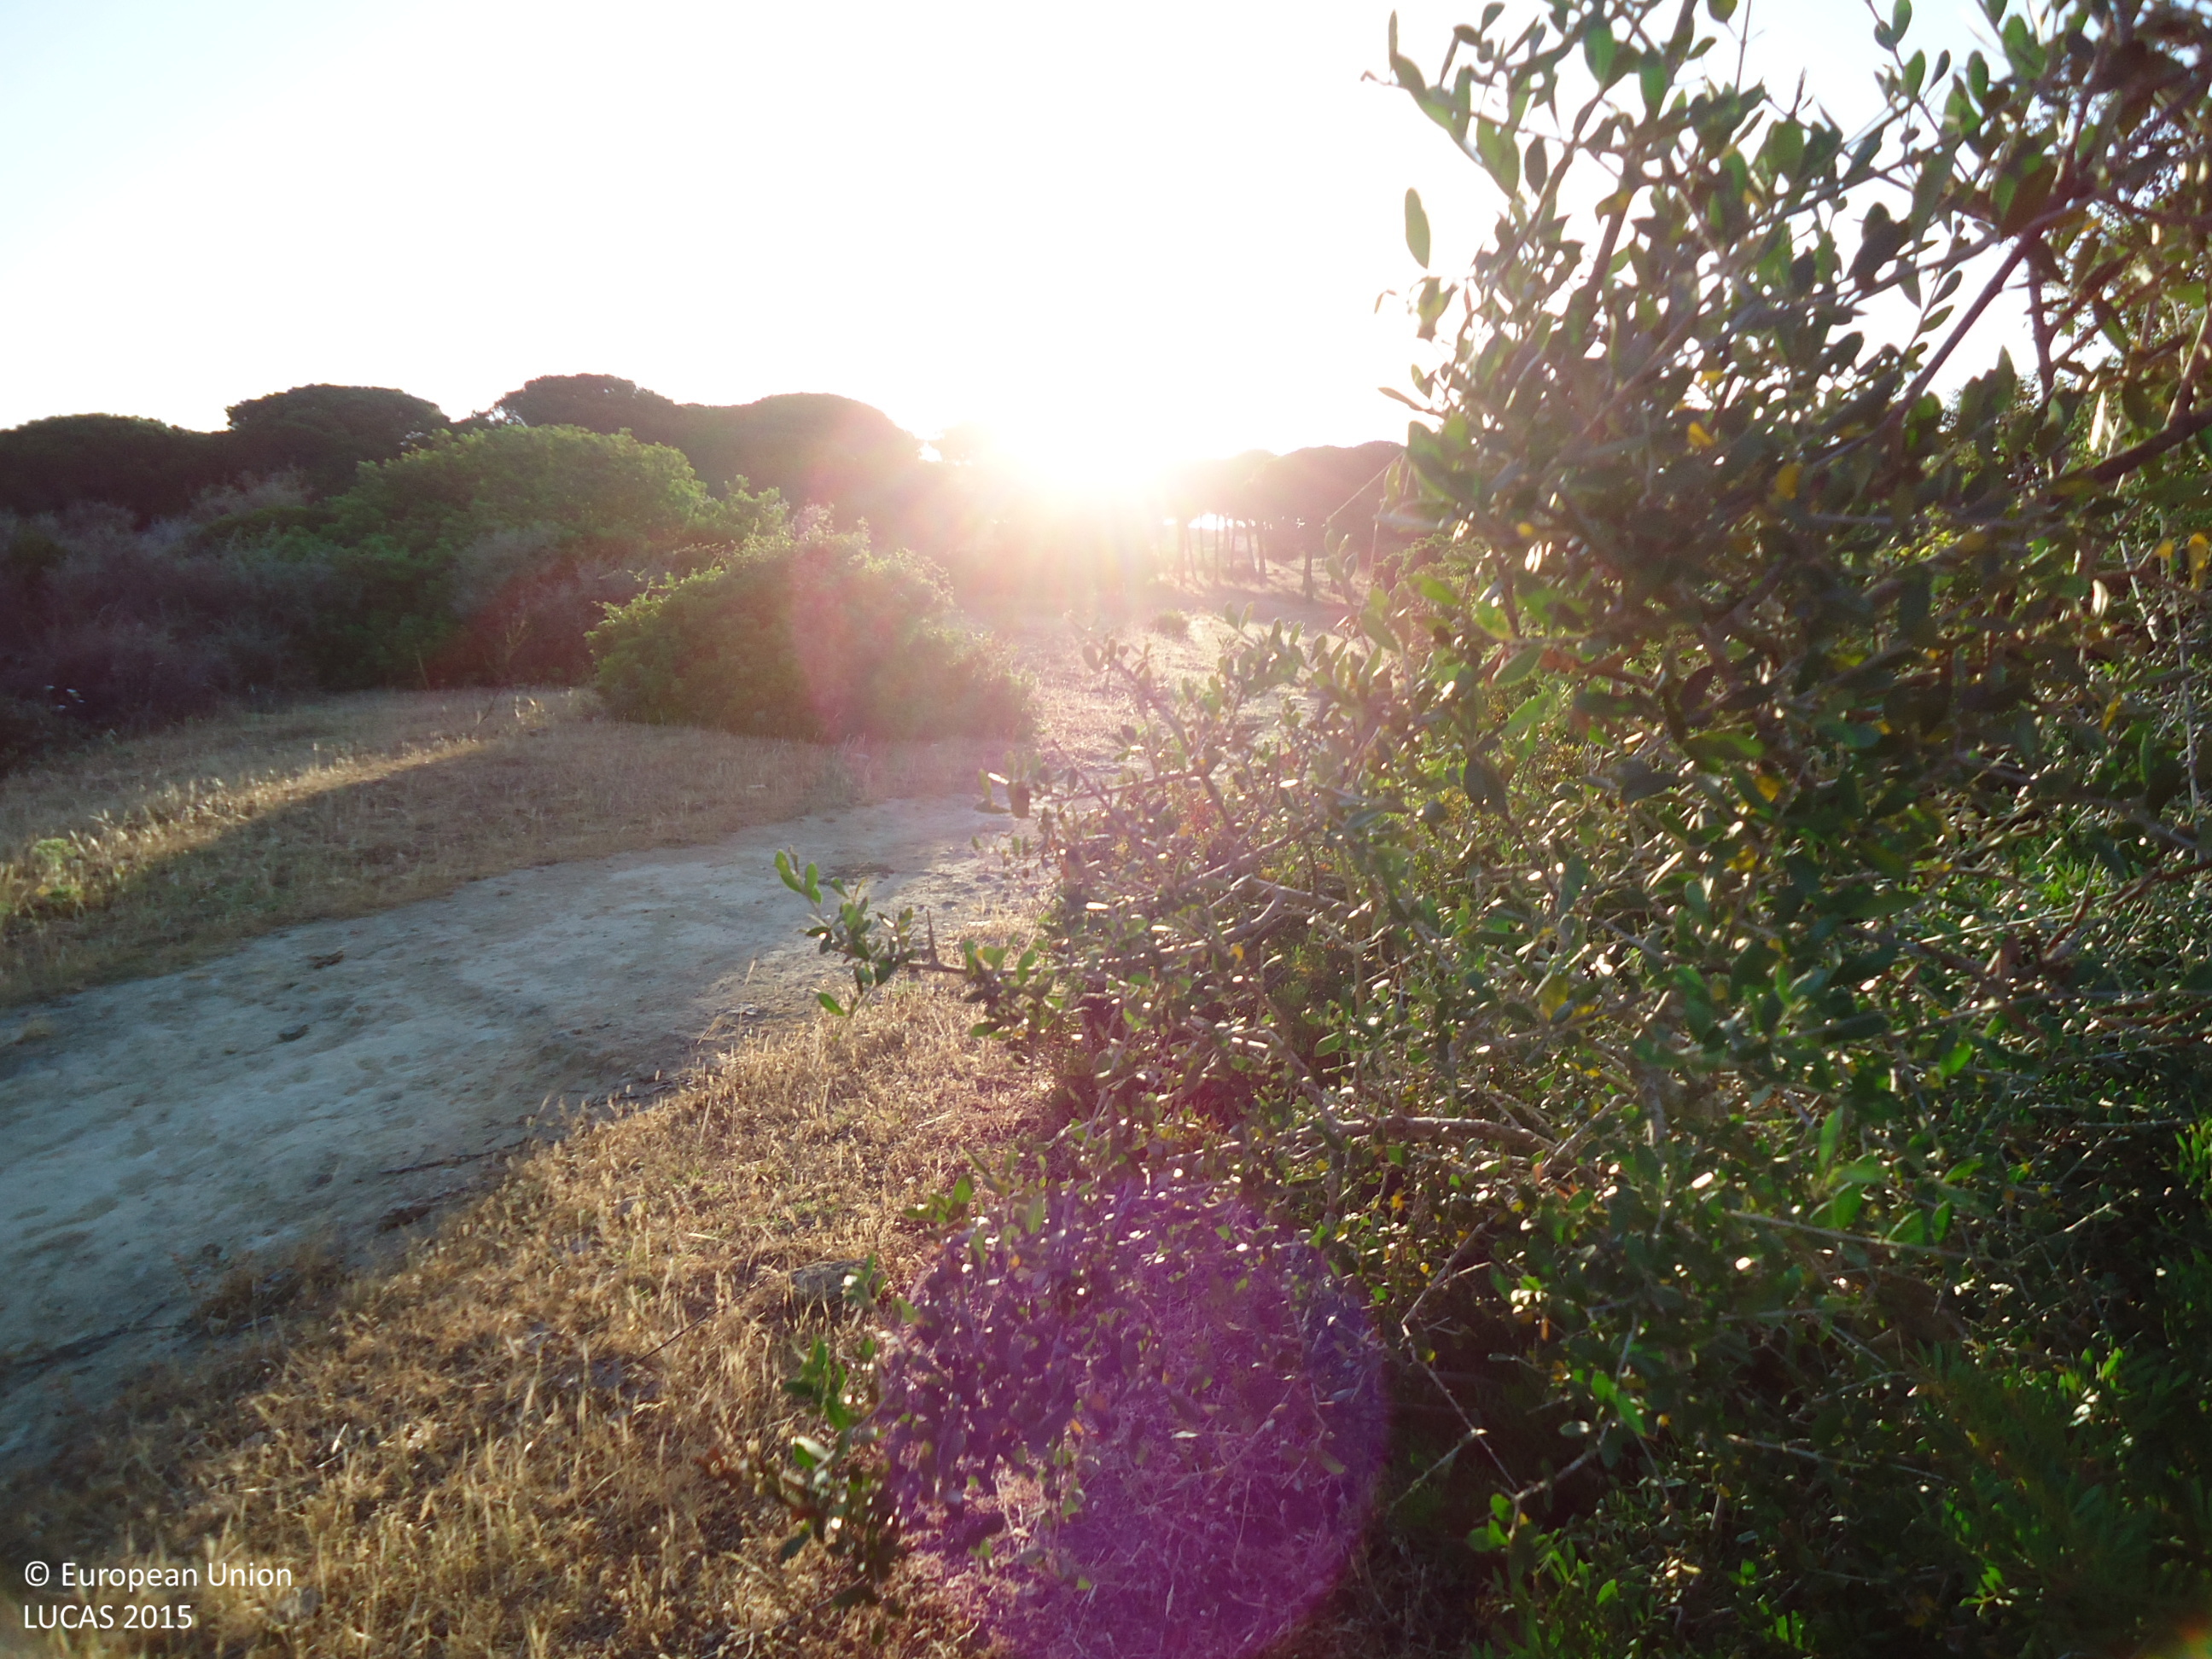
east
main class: Shrubland
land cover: Shrubland without tree cover
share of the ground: 25 - 50 %
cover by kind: herbaceous plants 60 %, shrubs 40 %
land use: Agriculture (excluding fallow land and kitchen gardens)
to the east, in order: Shrubland without tree cover; Spontaneously vegetated surfaces; Pine dominated coniferous woodland; Grassland with sparse tree/shrub cover
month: June
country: ES
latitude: 36.3373
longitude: -5.2898
